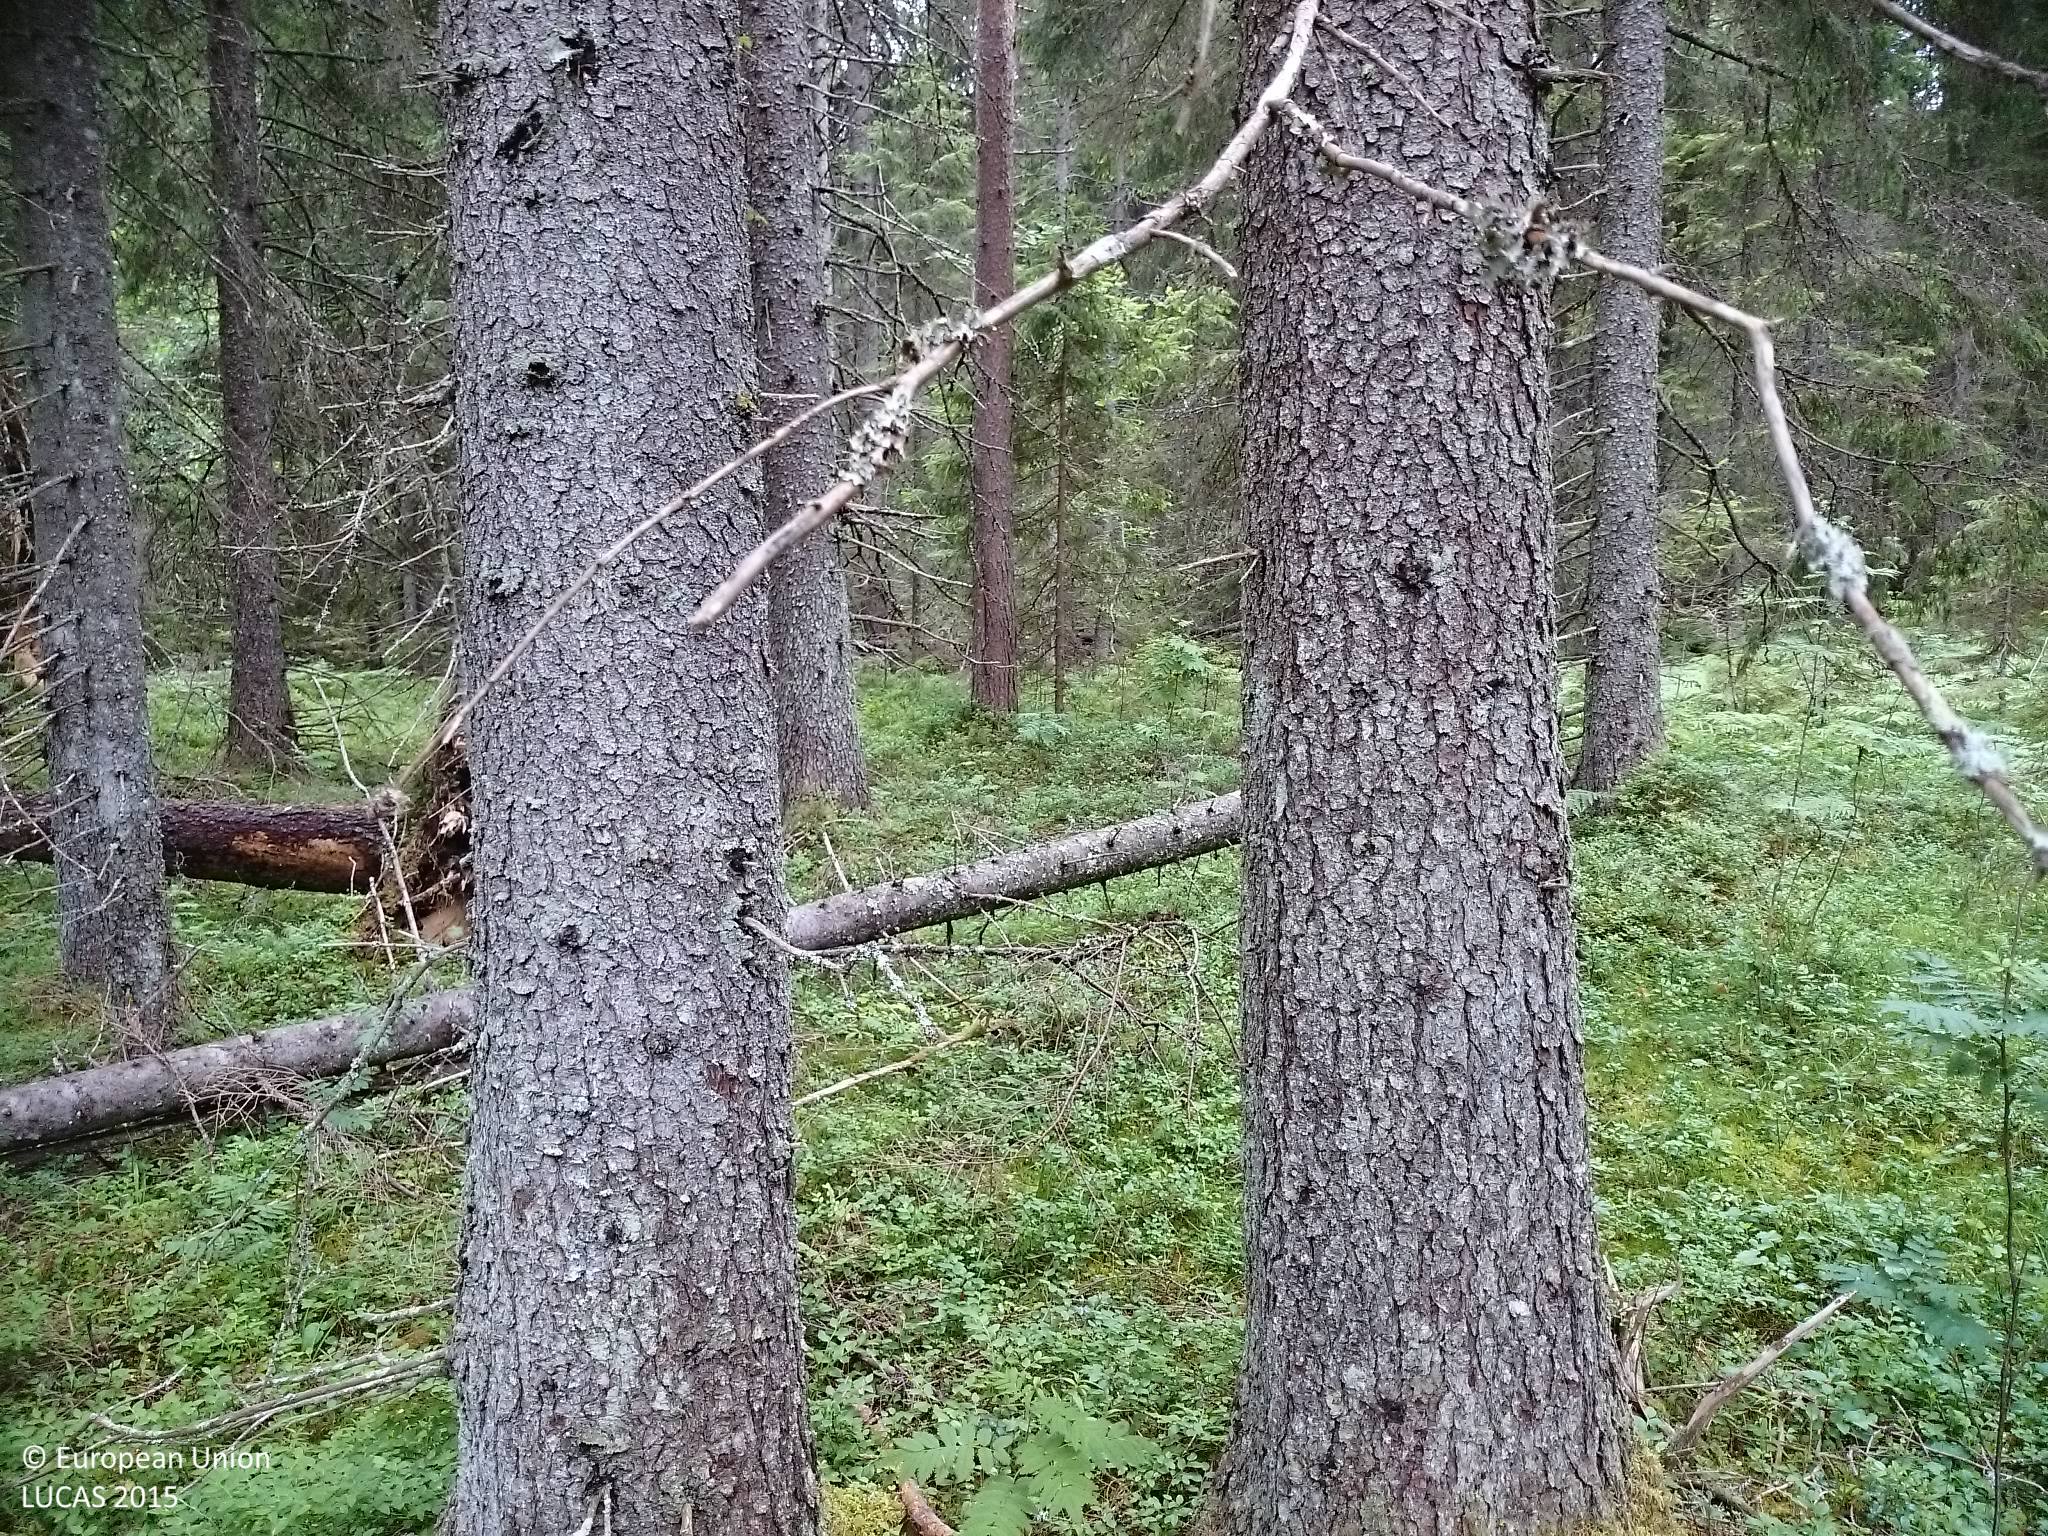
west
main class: Woodland
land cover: Spruce dominated coniferous woodland
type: boreal forest
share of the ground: 50 - 75 %
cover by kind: coniferous forest trees 60 %, shrubs 20 %, lichens and mosses 20 %
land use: Forestry
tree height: > 5 m
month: July
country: SE
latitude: 62.5184
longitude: 17.8088
